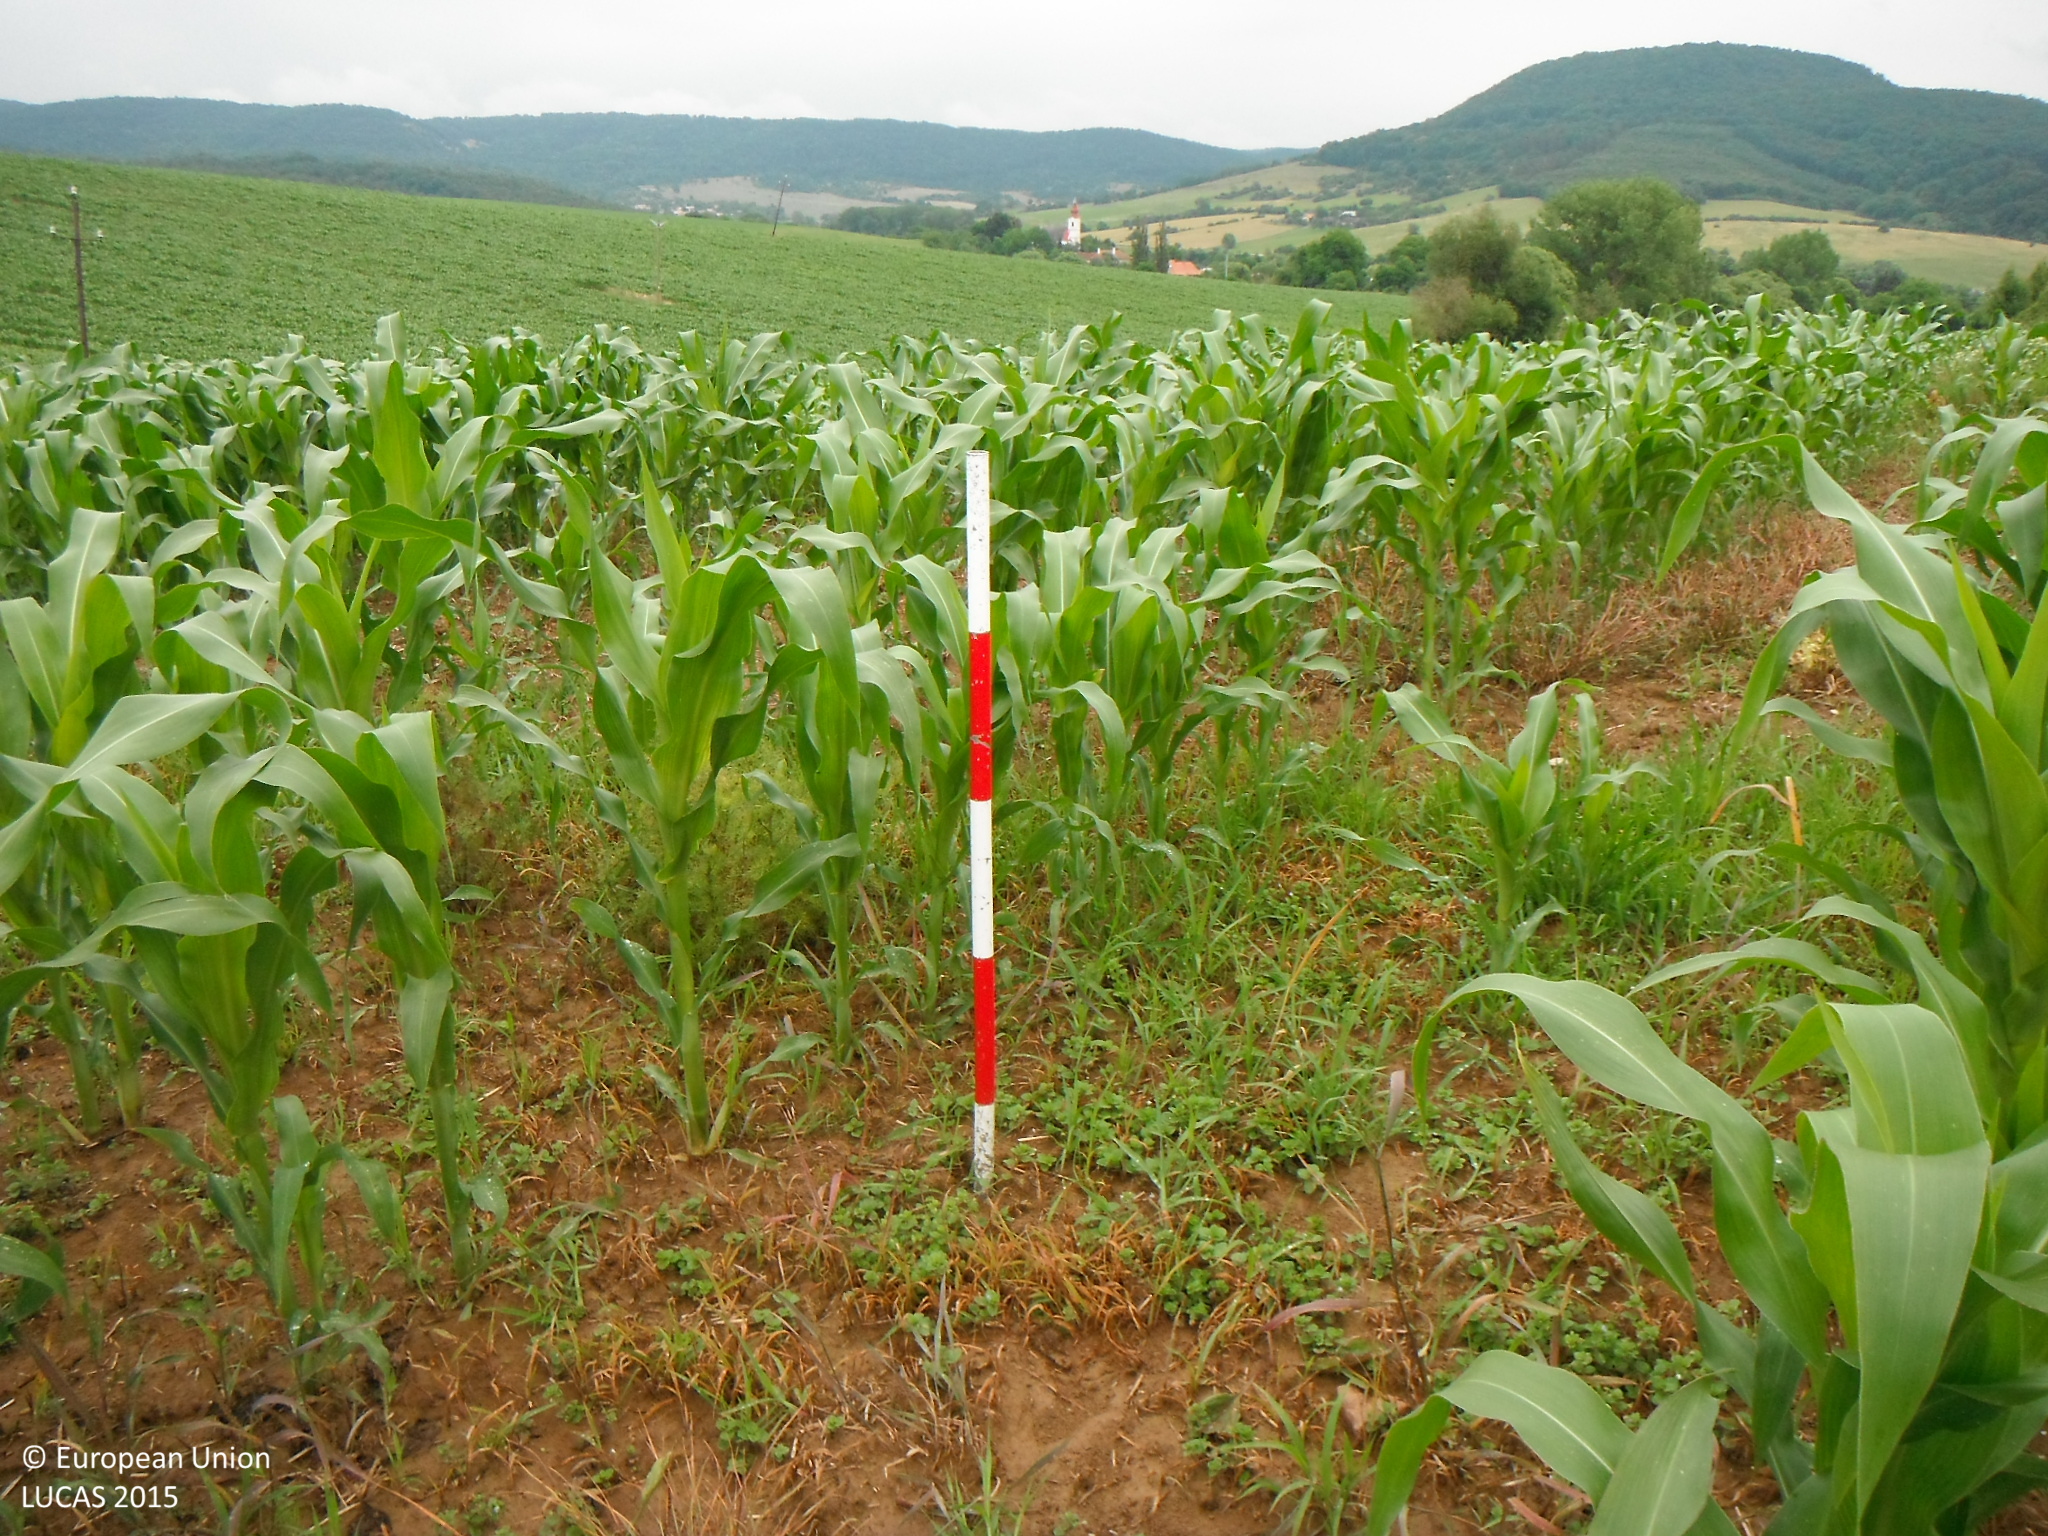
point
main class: Cropland
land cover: Maize
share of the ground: 50 - 75 %
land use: Agriculture (excluding fallow land and kitchen gardens)
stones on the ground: < 10 %
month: June
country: SK
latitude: 48.4854
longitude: 20.0830
